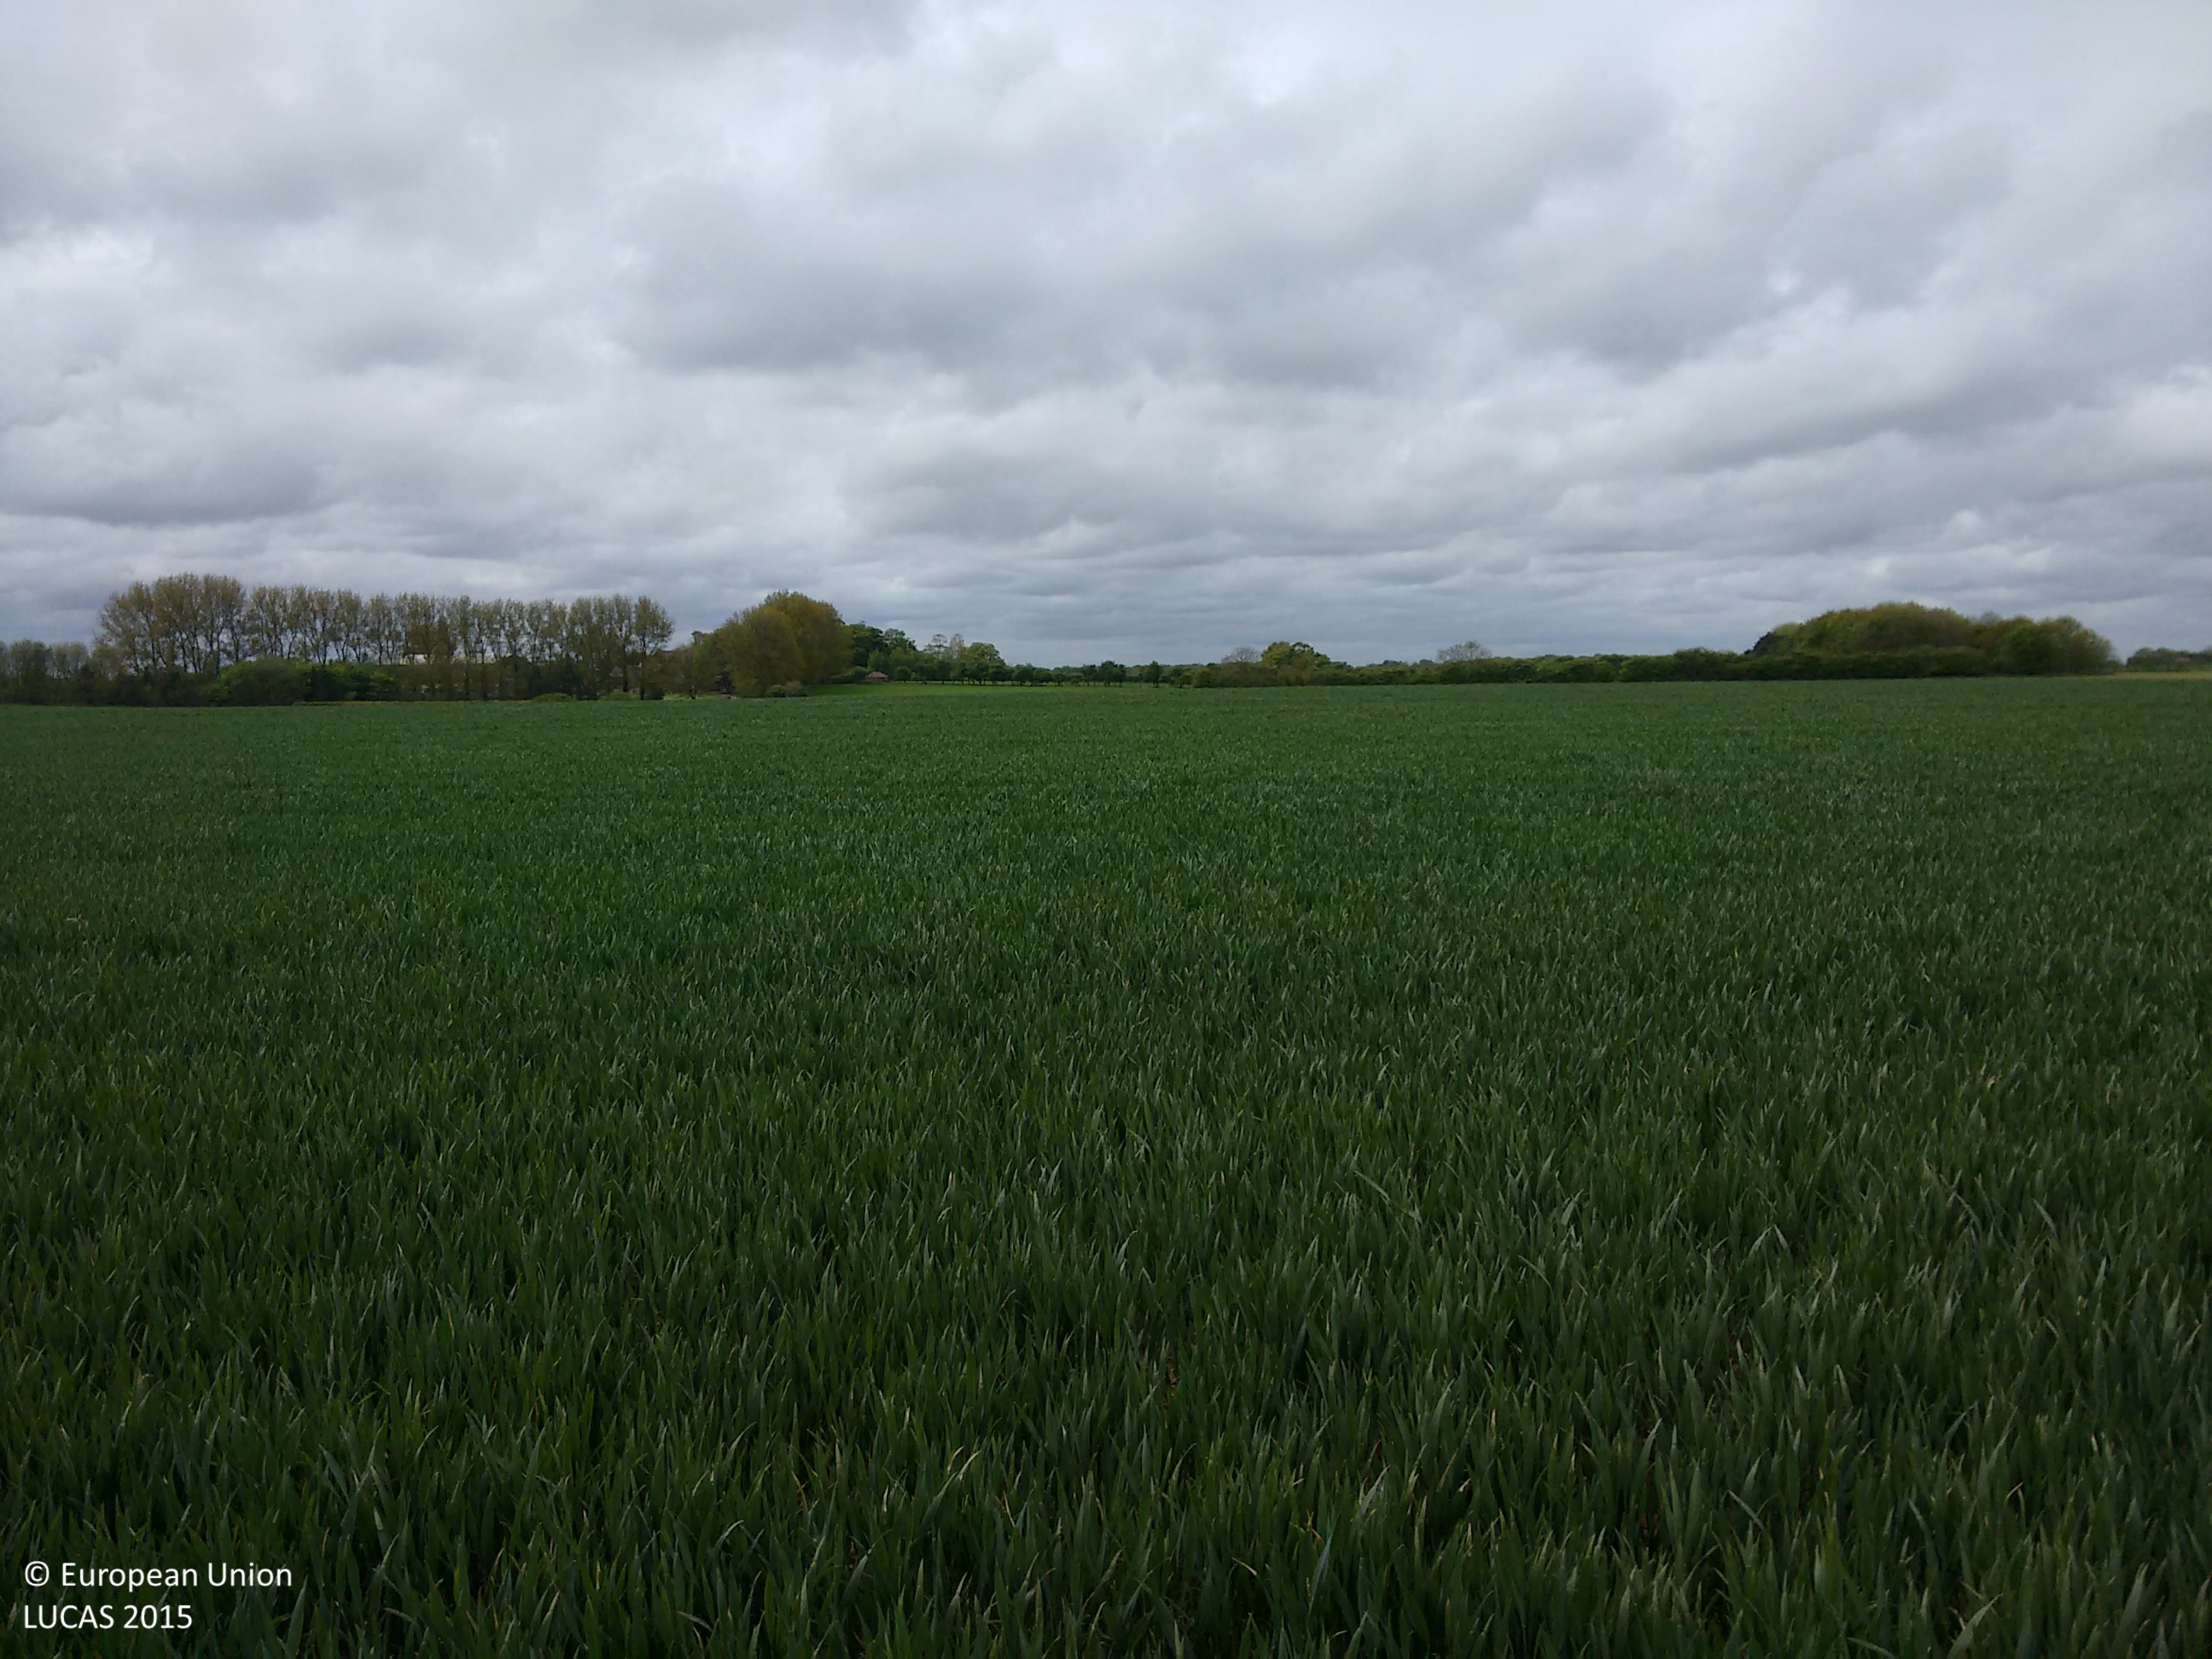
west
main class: Cropland
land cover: Common wheat
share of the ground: > 75 %
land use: Agriculture (excluding fallow land and kitchen gardens)
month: May
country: GB
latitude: 53.8249
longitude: -0.1661
